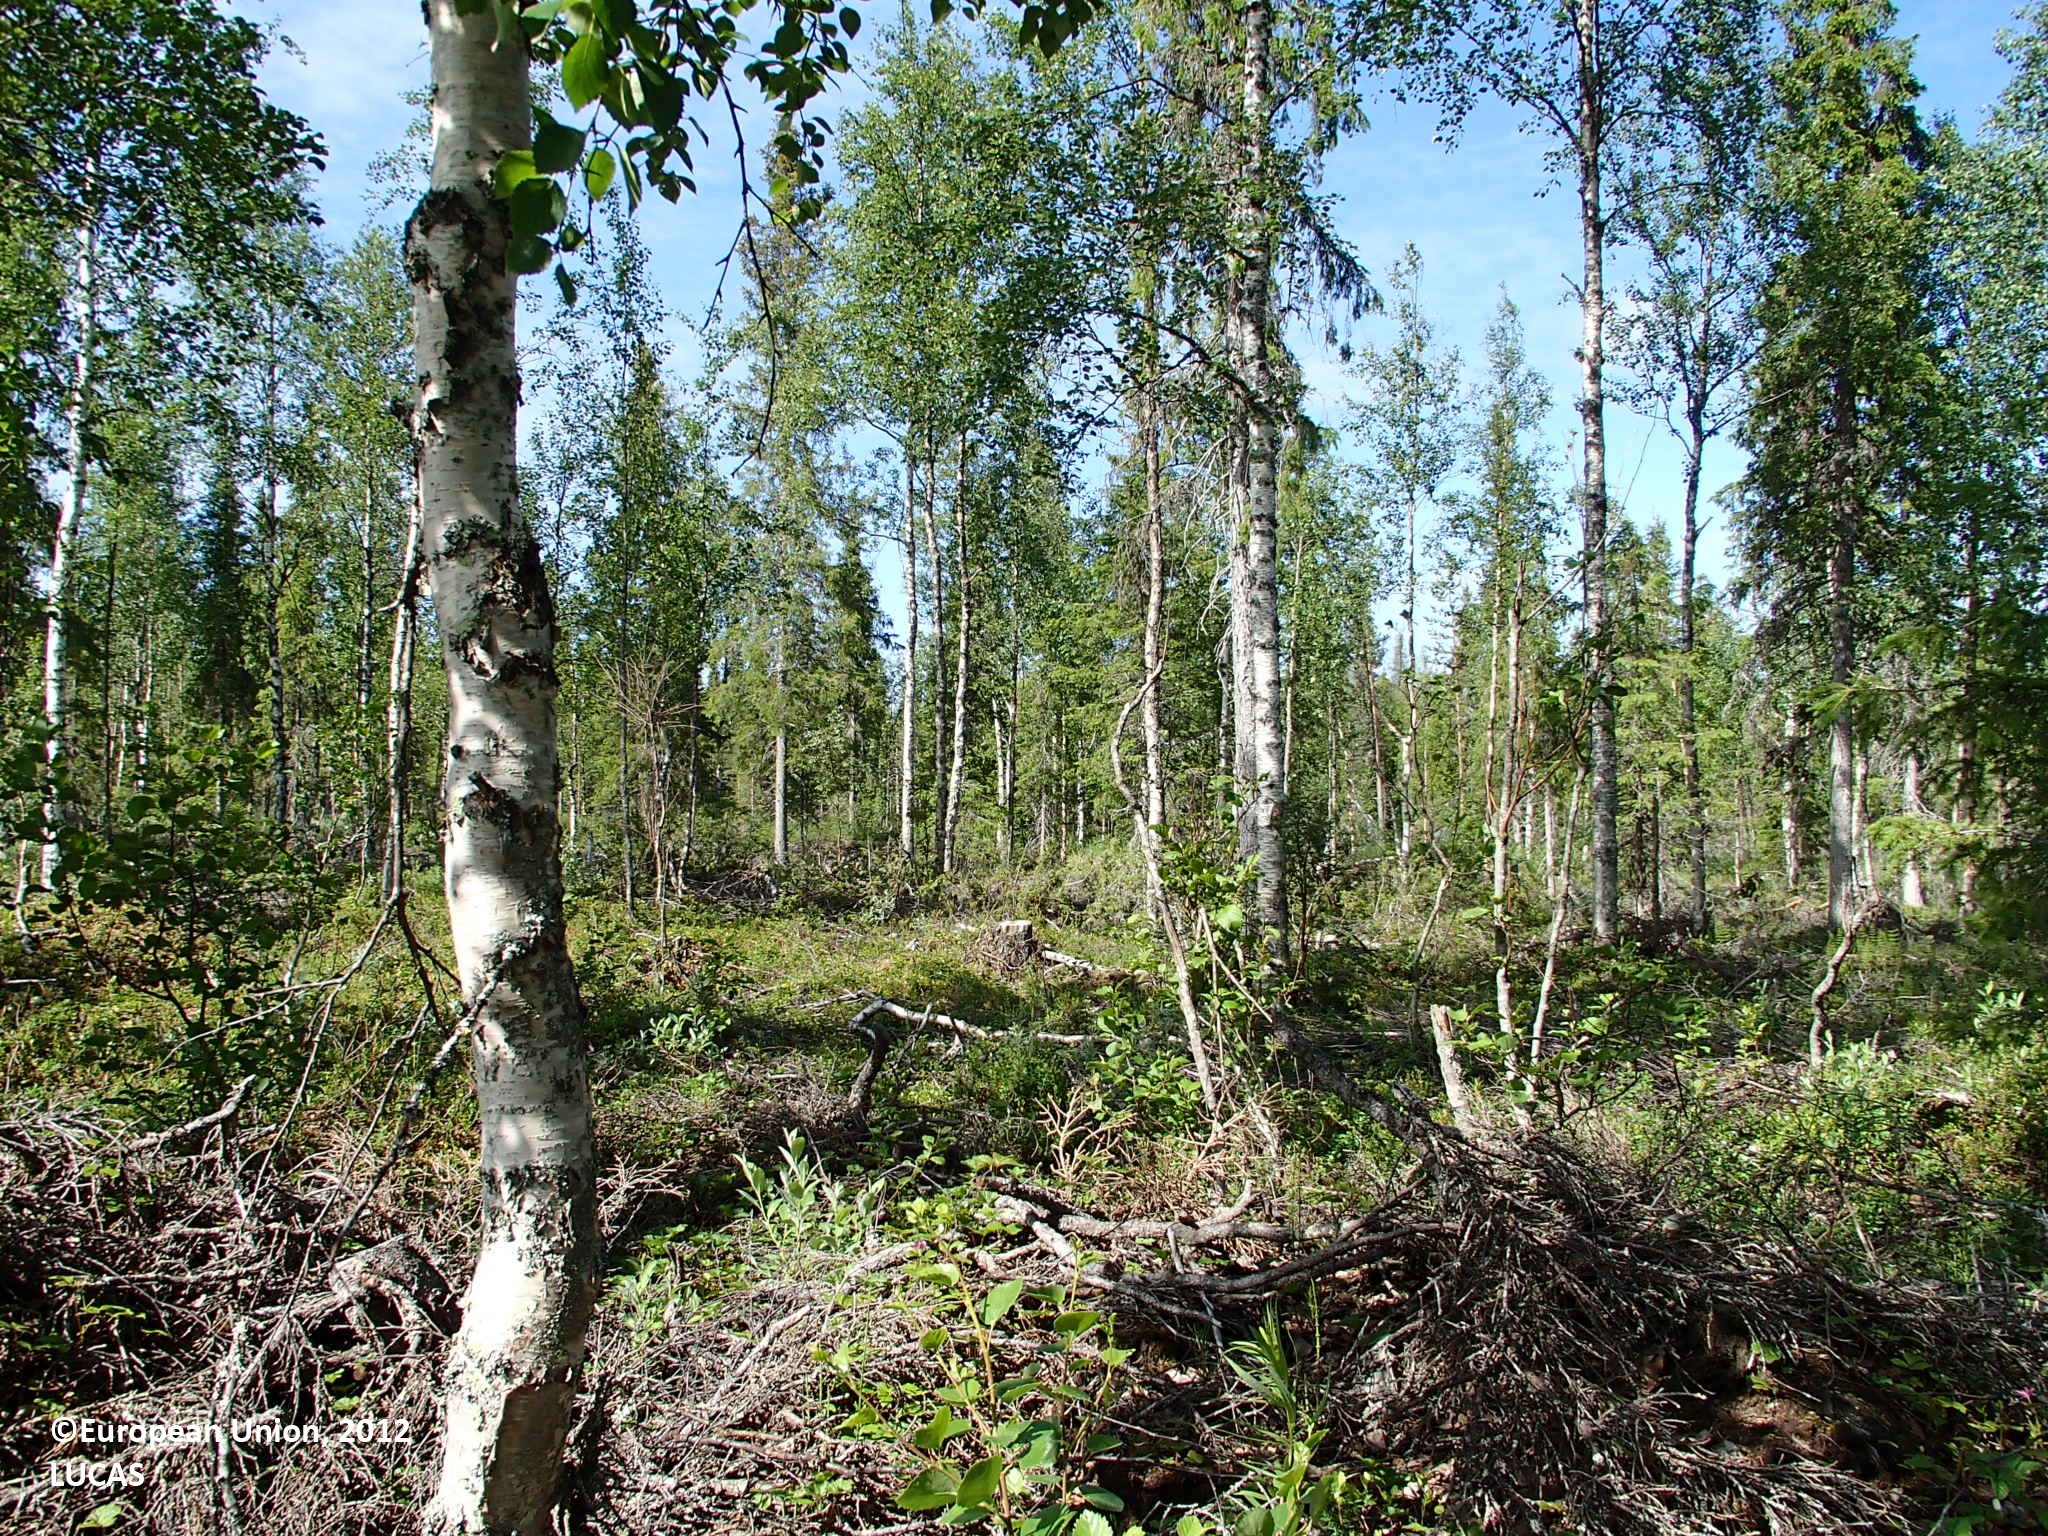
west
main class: Woodland
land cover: Broadleaved woodland
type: boreal forest
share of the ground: 50 - 75 %
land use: Forestry
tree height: > 5 m
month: July
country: FI
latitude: 67.3847
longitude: 26.1680
